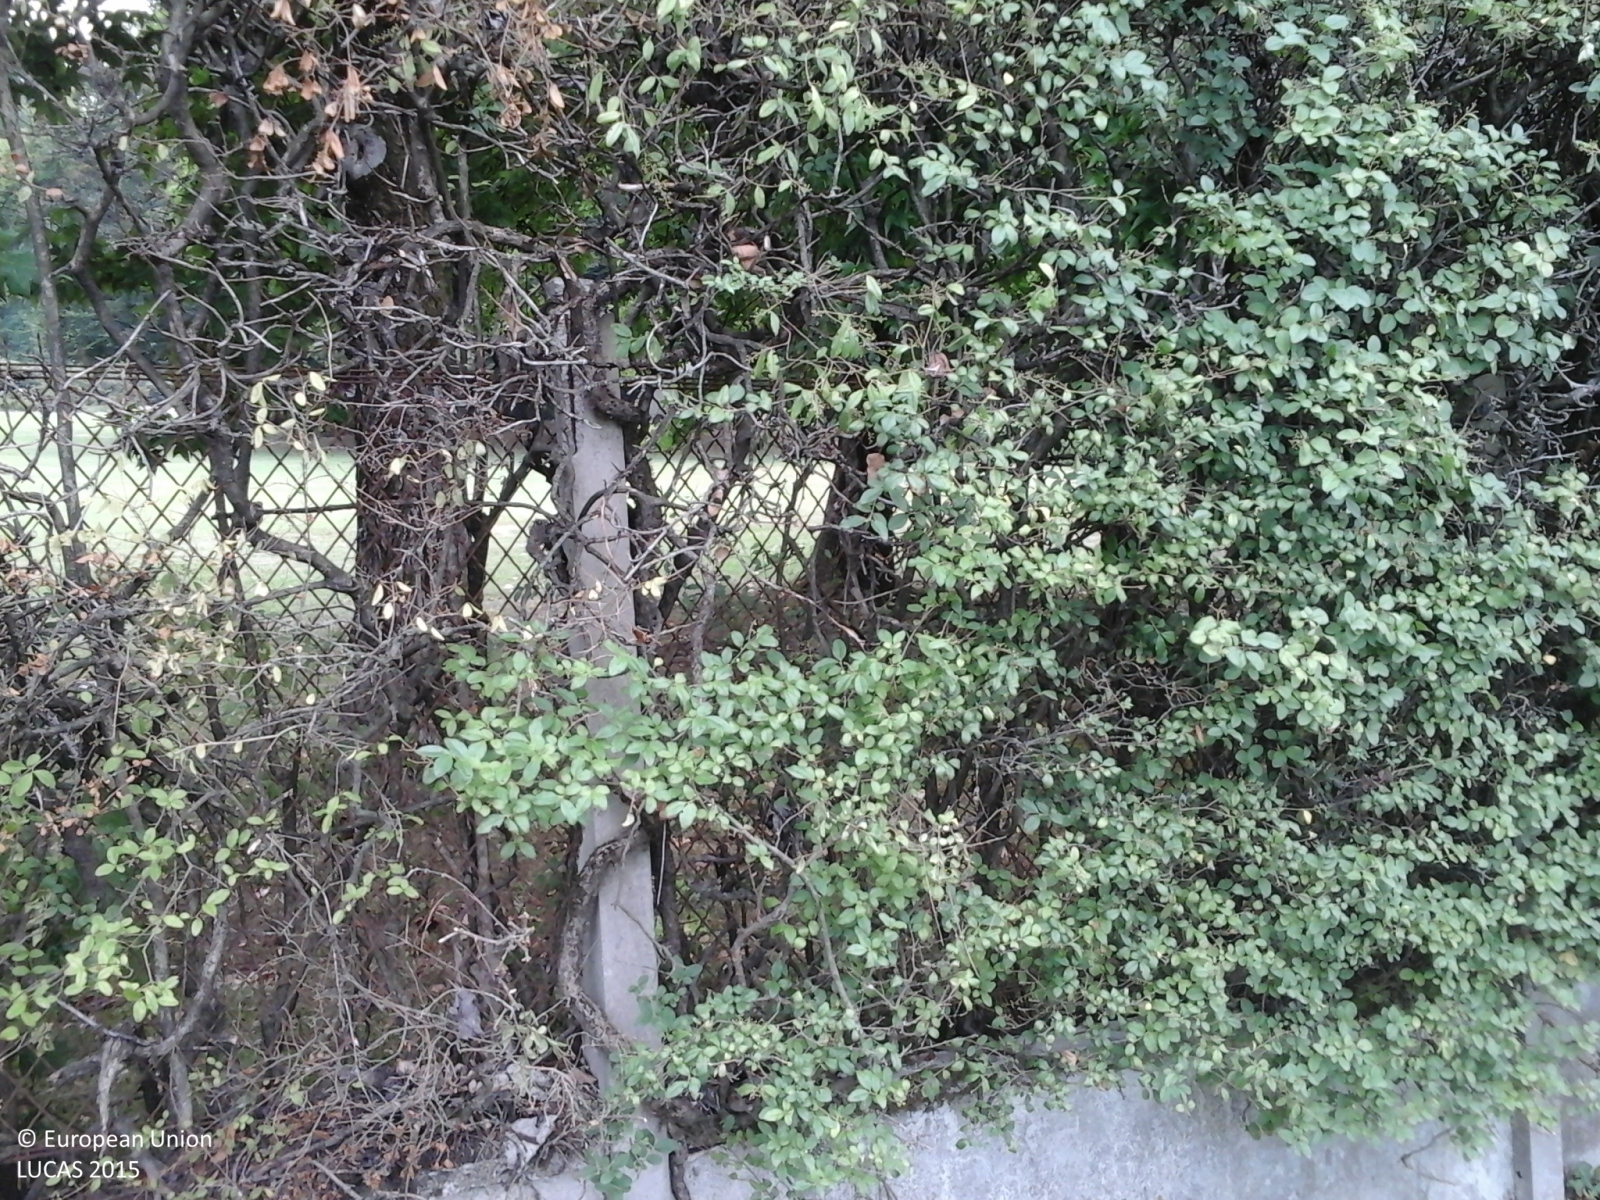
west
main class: Grassland
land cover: Grassland without tree/shrub cover
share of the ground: > 75 %
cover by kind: herbaceous plants 100 %
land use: Residential
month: August
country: IT
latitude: 45.6629
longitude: 9.1158
